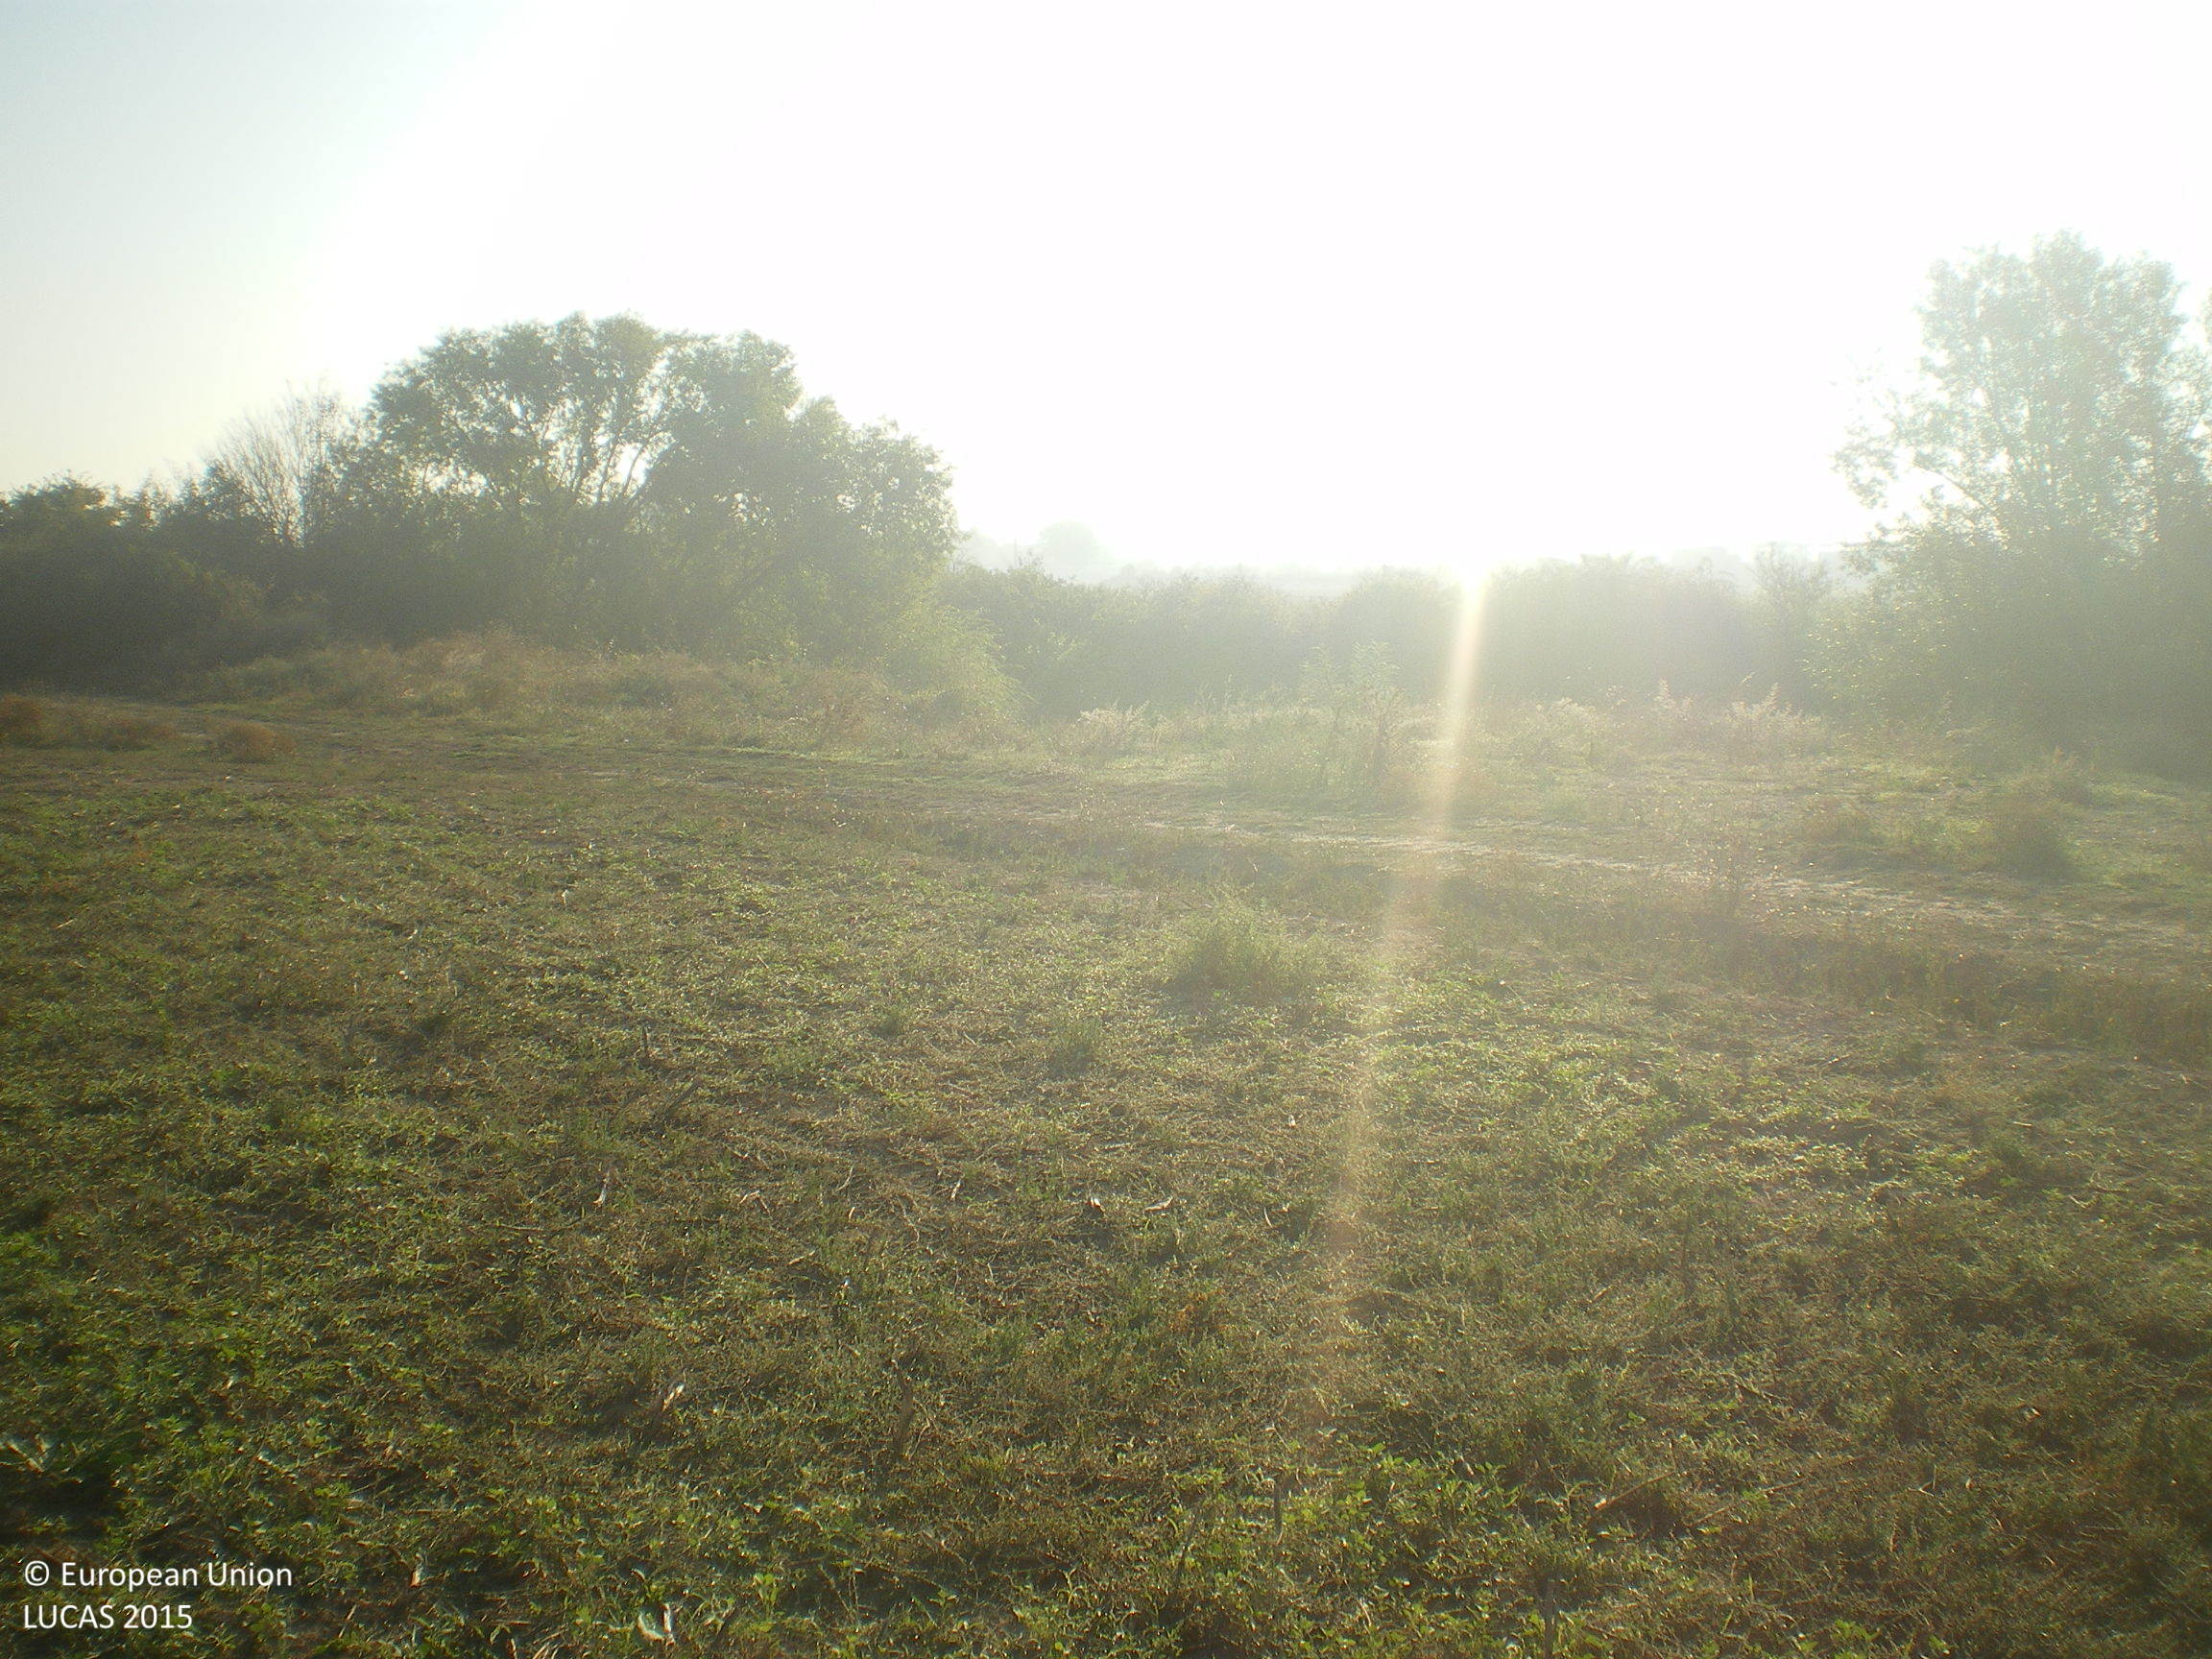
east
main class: Cropland
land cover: Rape and turnip rape
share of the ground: < 10 %
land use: Agriculture (excluding fallow land and kitchen gardens)
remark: Harvested field
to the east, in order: Rape and turnip rape; Grass margins; Tracks; Grassland without tree/shrub cover; Broadleaved woodland; Rivers and streams; Shrubland with sparse tree cover; Grass margins; Tracks; Grass margins; Sunflower
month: September
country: BG
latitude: 41.7733
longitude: 26.1347
